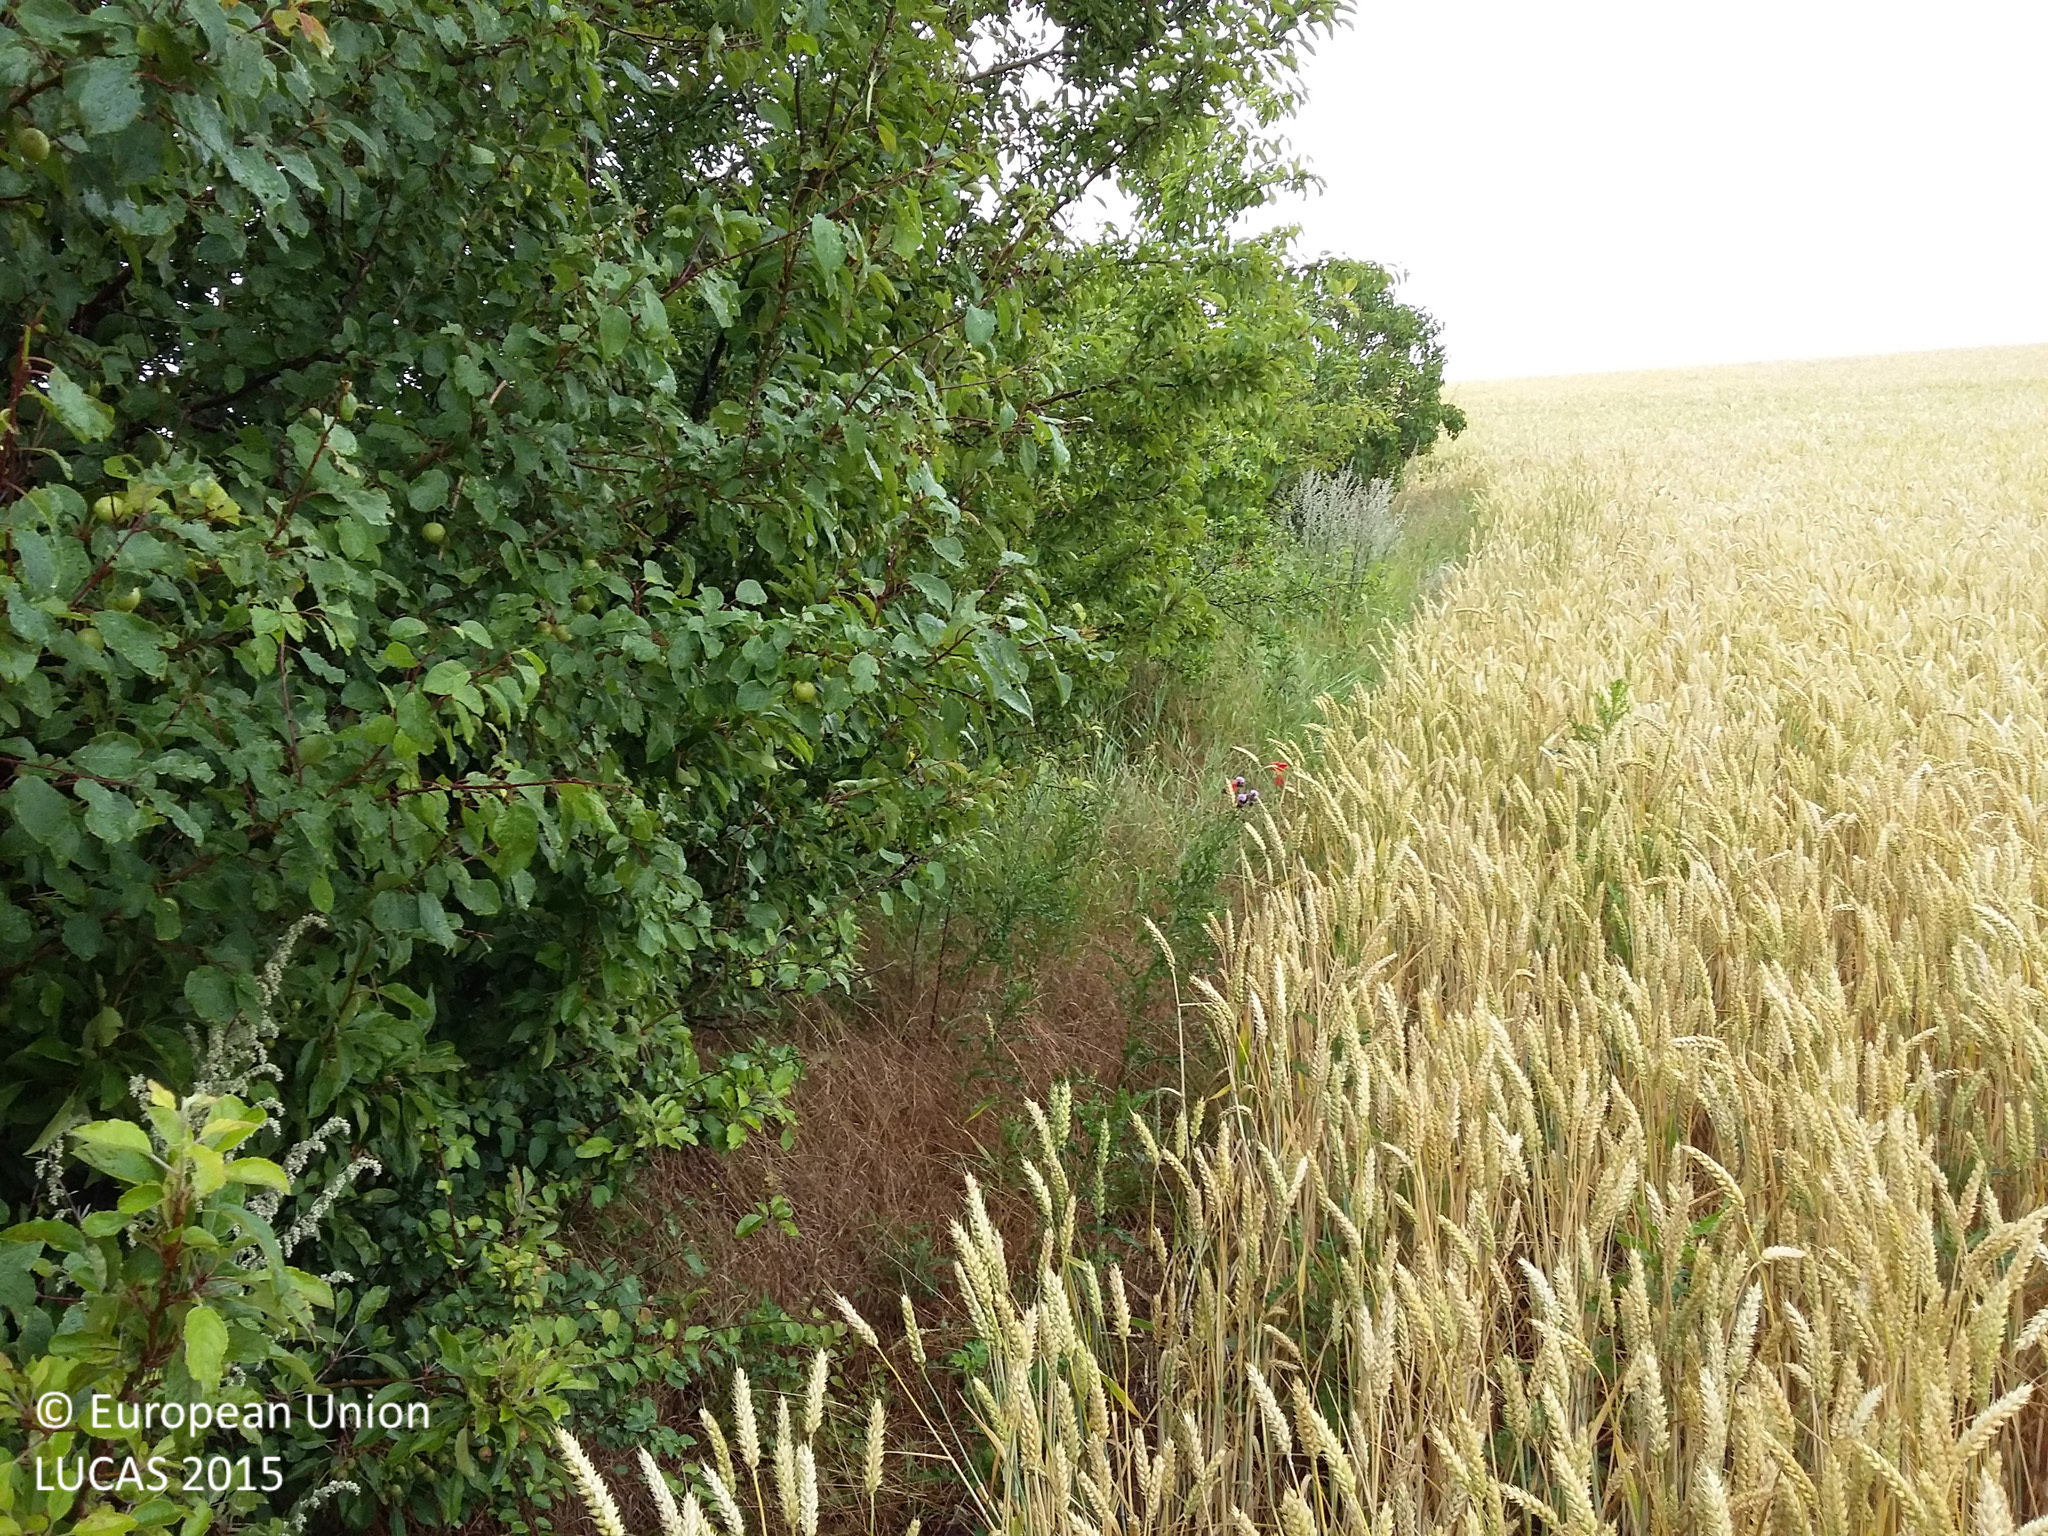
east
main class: Cropland
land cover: Common wheat
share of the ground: > 75 %
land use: Agriculture (excluding fallow land and kitchen gardens)
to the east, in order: Common wheat; Broadleaved woodland; Shrubland with sparse tree cover; Common wheat
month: July
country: DK
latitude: 55.8291
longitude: 12.0894
